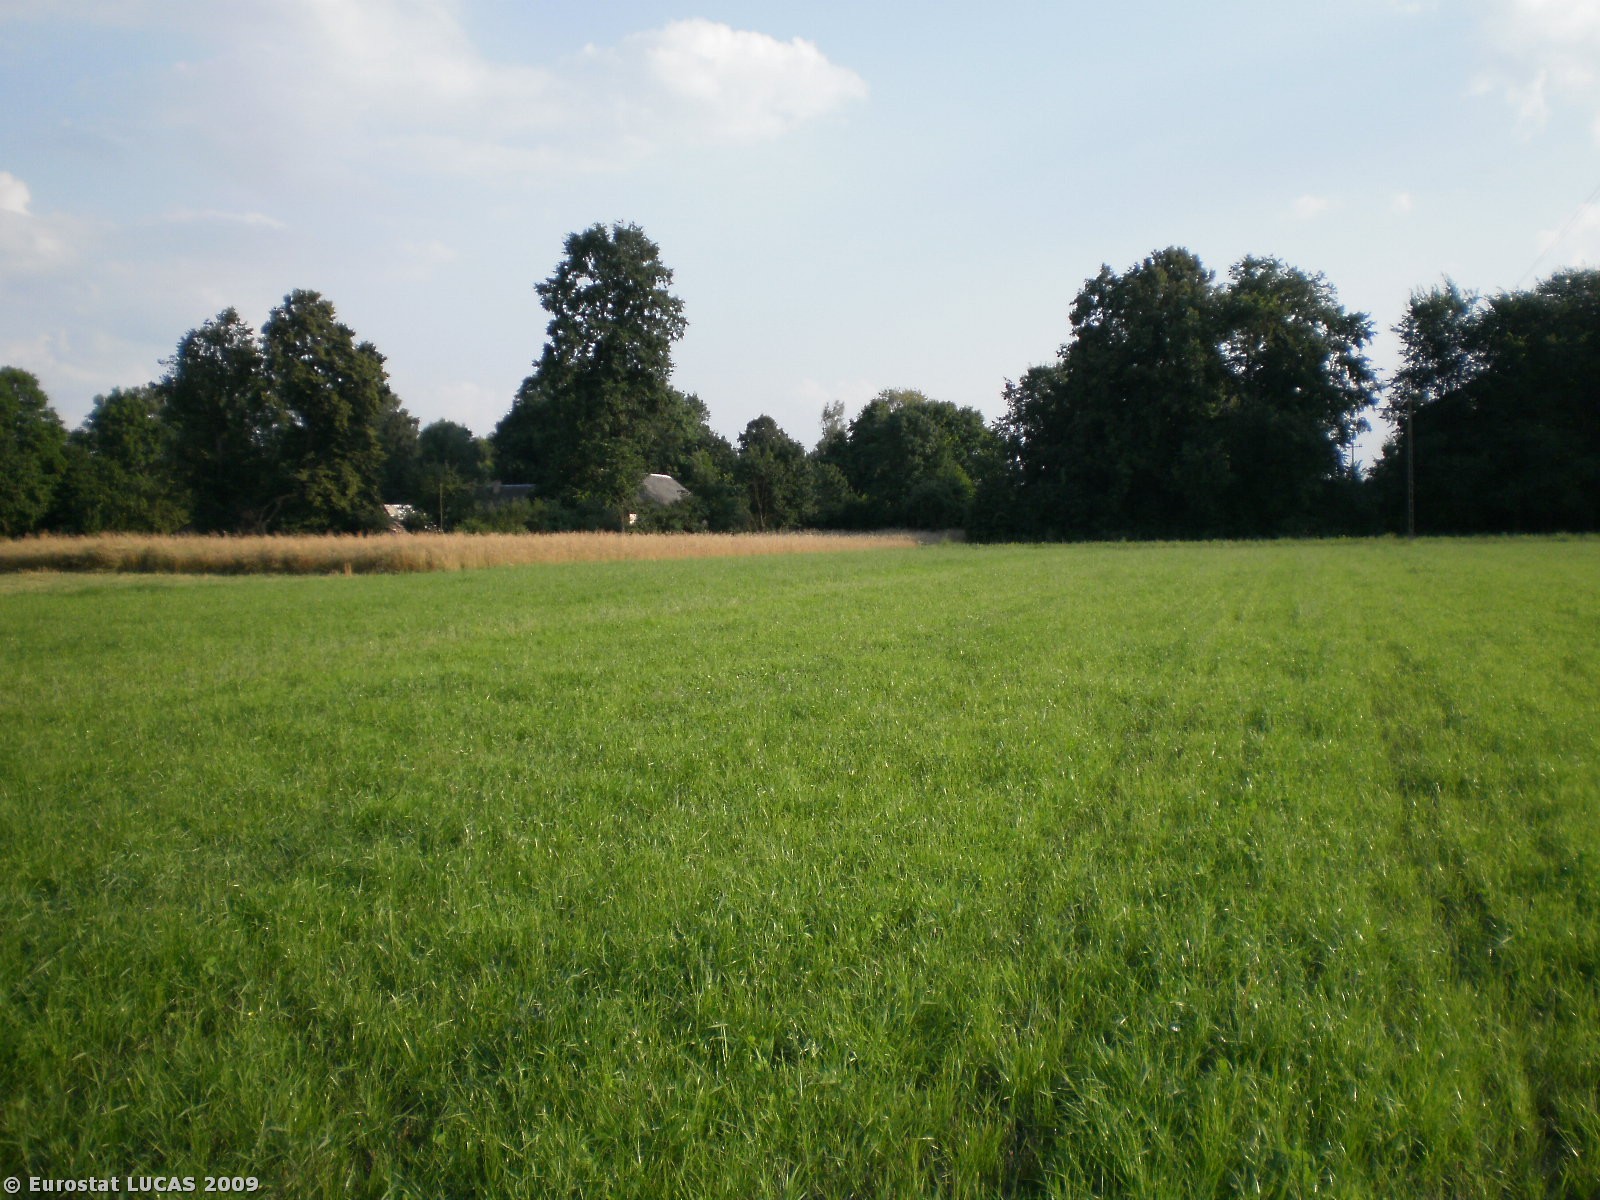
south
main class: Grassland
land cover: Grassland without tree/shrub cover
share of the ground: > 75 %
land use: Agriculture (excluding fallow land and kitchen gardens)
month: July
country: PL
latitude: 53.4498
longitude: 21.3259
